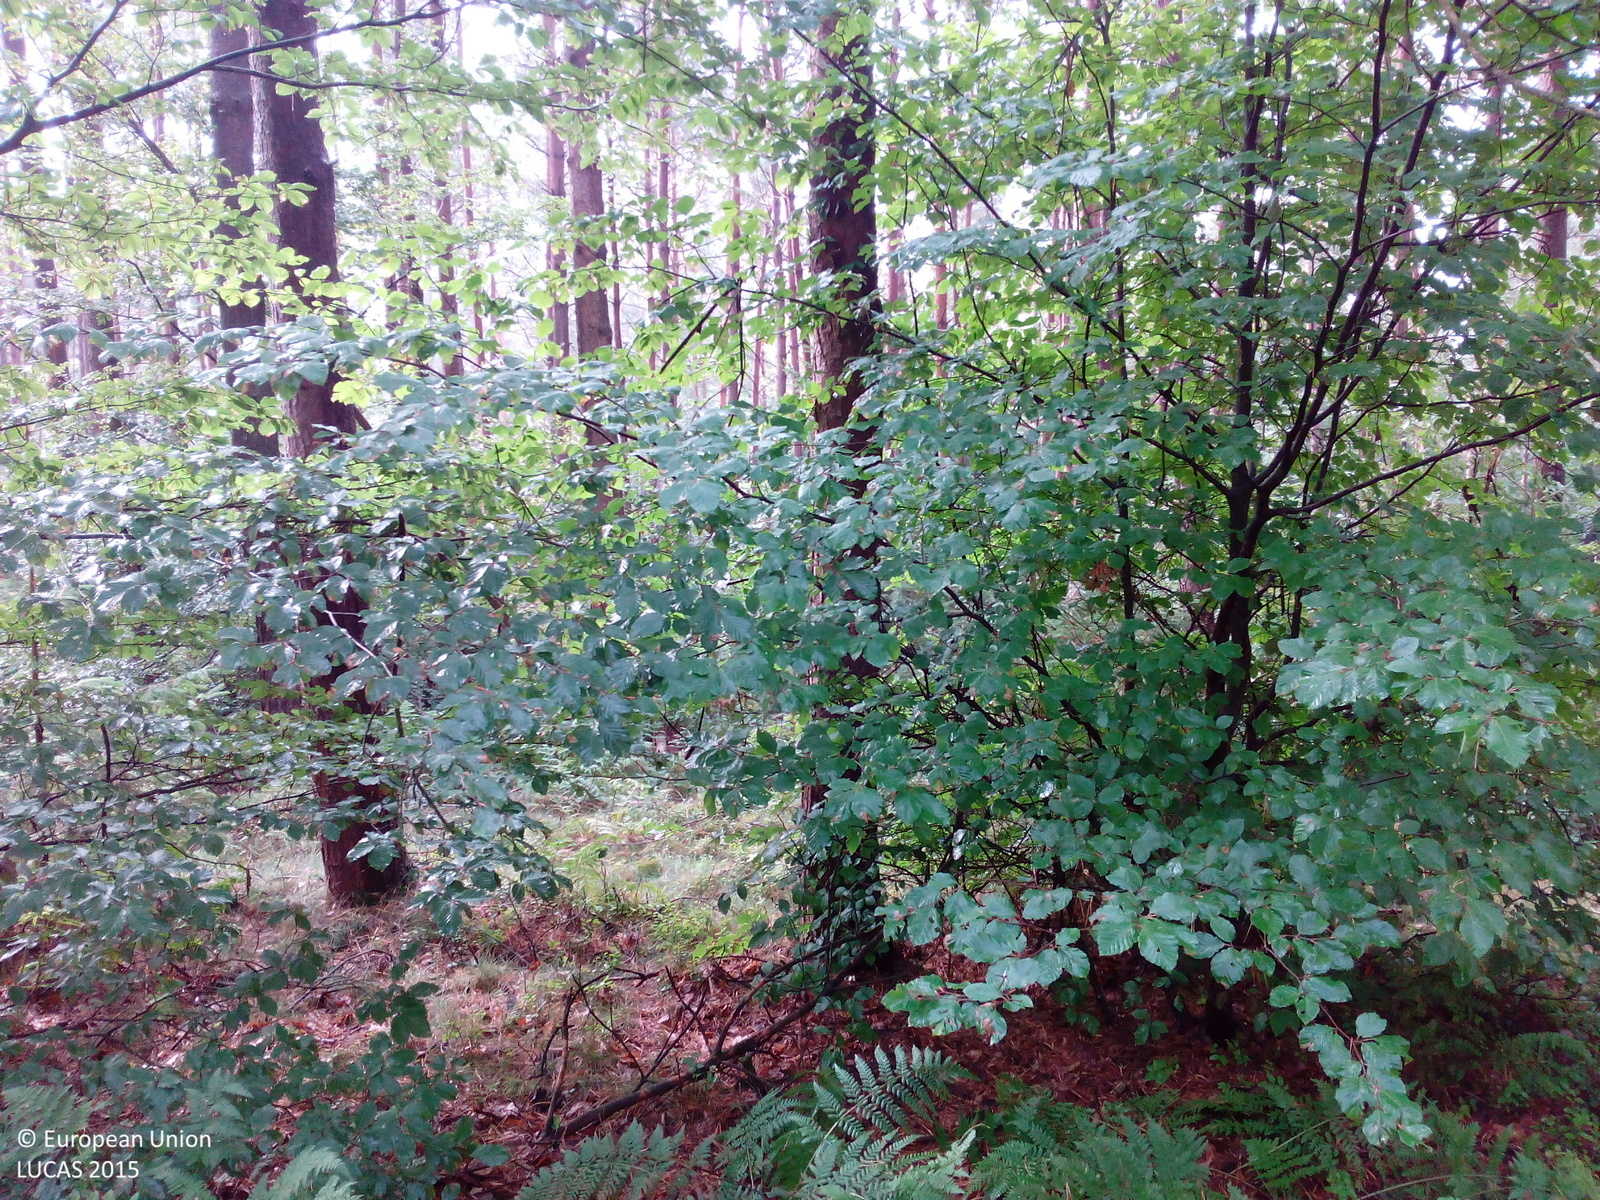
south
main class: Woodland
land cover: Other coniferous woodland
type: hemiboreal forest and nemoral coniferous forest and mixed broadleaved-coniferous forest
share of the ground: > 75 %
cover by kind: coniferous forest trees 70 %, broadleaved forest trees 20 %, shrubs 5 %, herbaceous plants 5 %
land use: Forestry
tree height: > 5 m
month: September
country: DE
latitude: 50.0388
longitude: 9.3998
